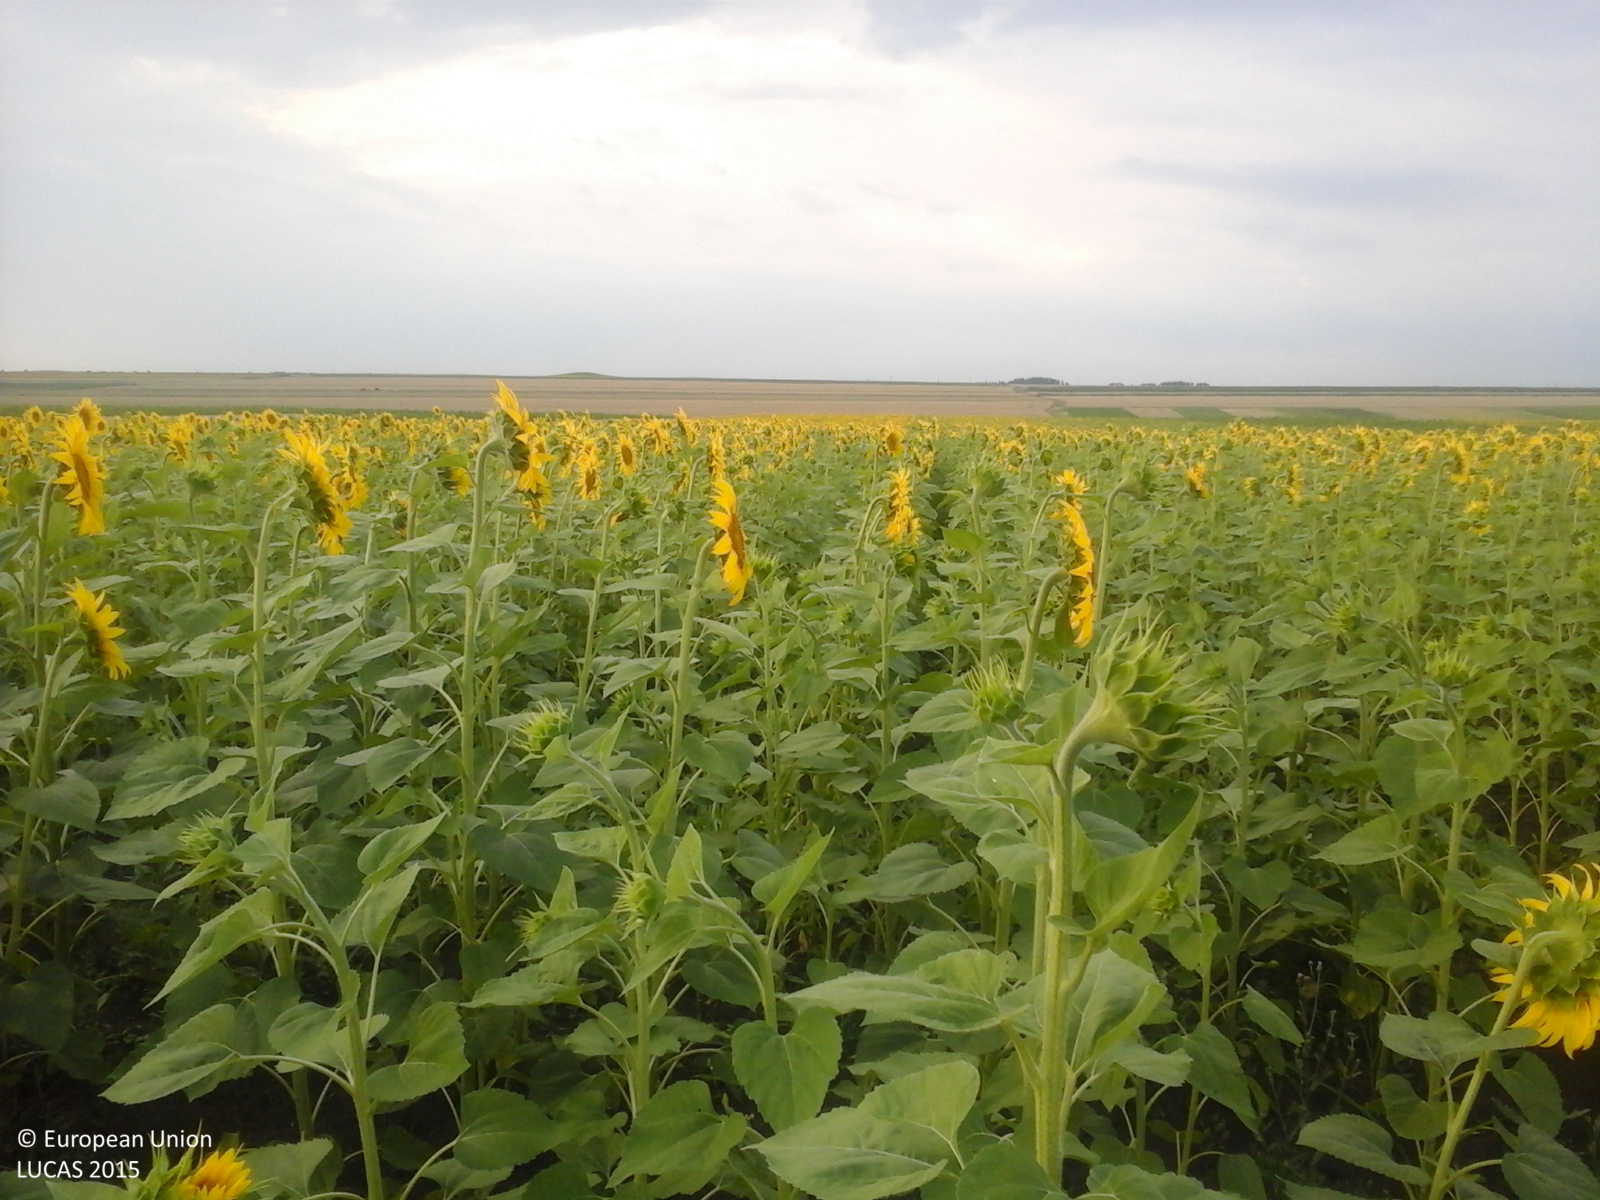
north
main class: Cropland
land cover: Sunflower
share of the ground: > 75 %
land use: Agriculture (excluding fallow land and kitchen gardens)
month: July
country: RO
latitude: 44.0385
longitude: 24.3779
